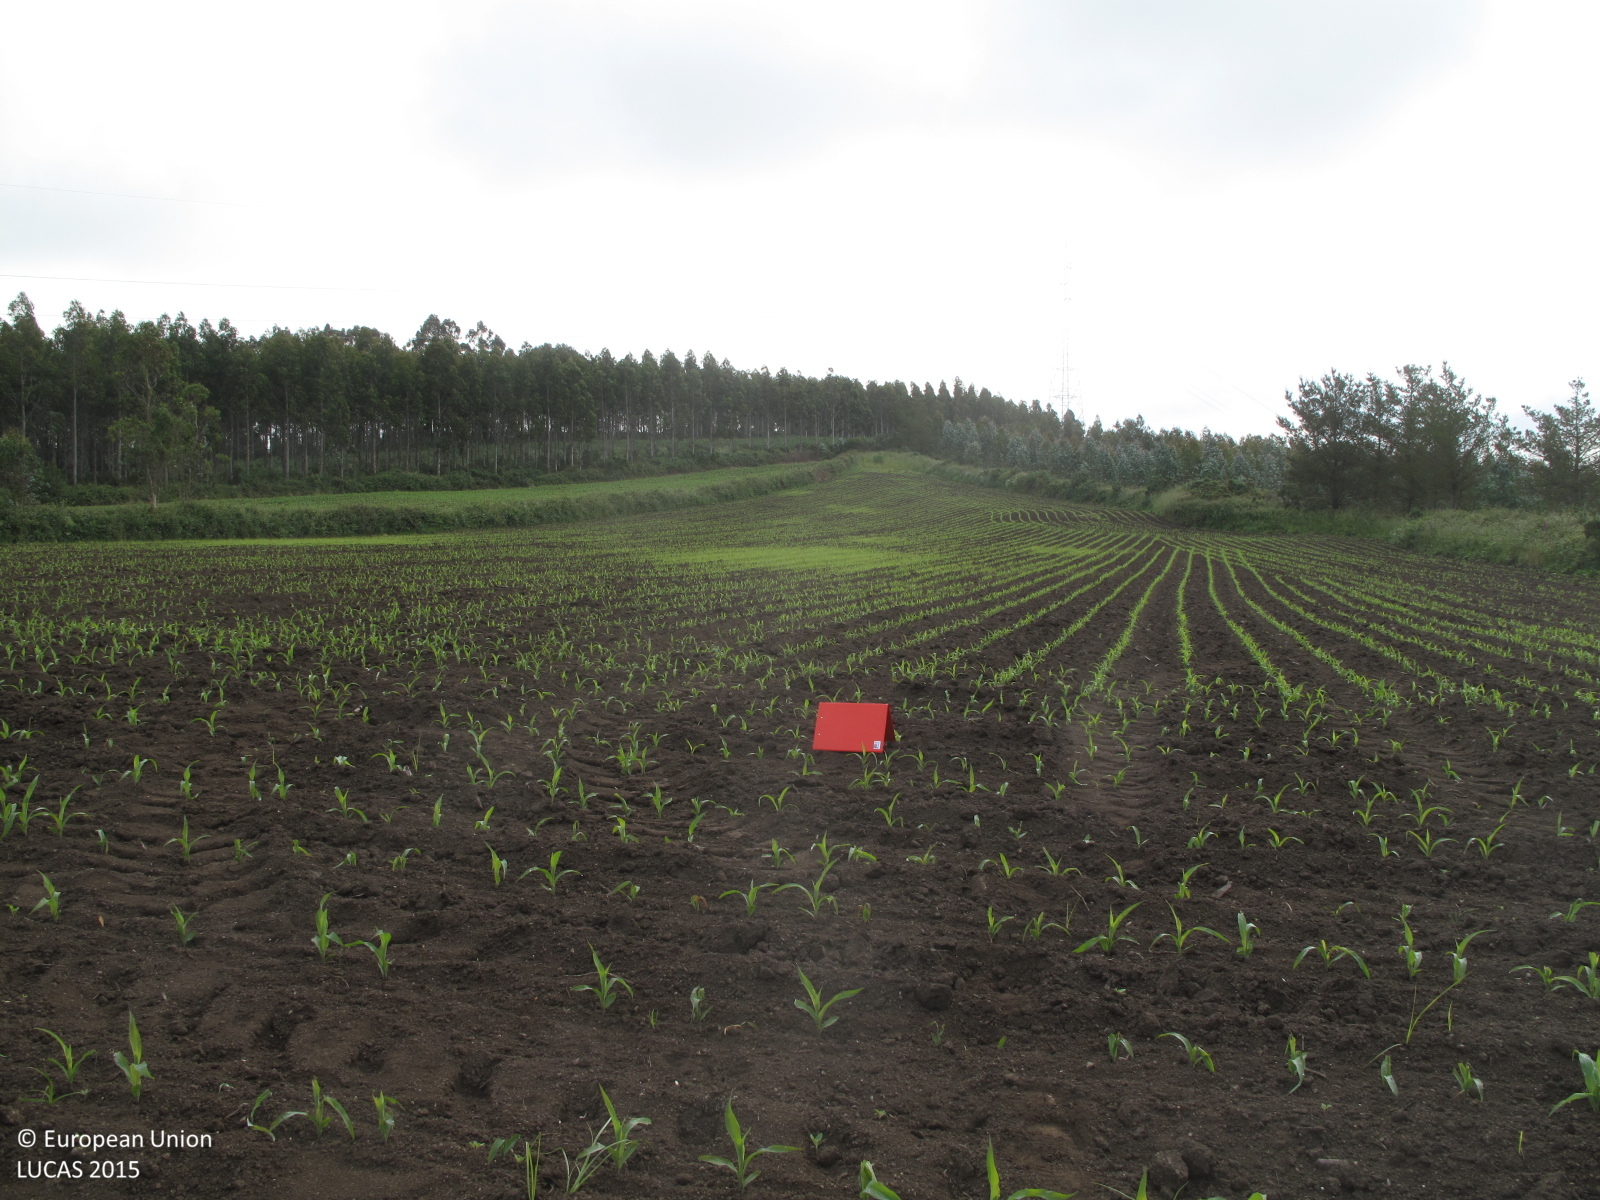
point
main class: Cropland
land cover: Maize
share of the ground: < 10 %
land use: Agriculture (excluding fallow land and kitchen gardens)
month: June
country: ES
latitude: 43.1771
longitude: -8.5498
